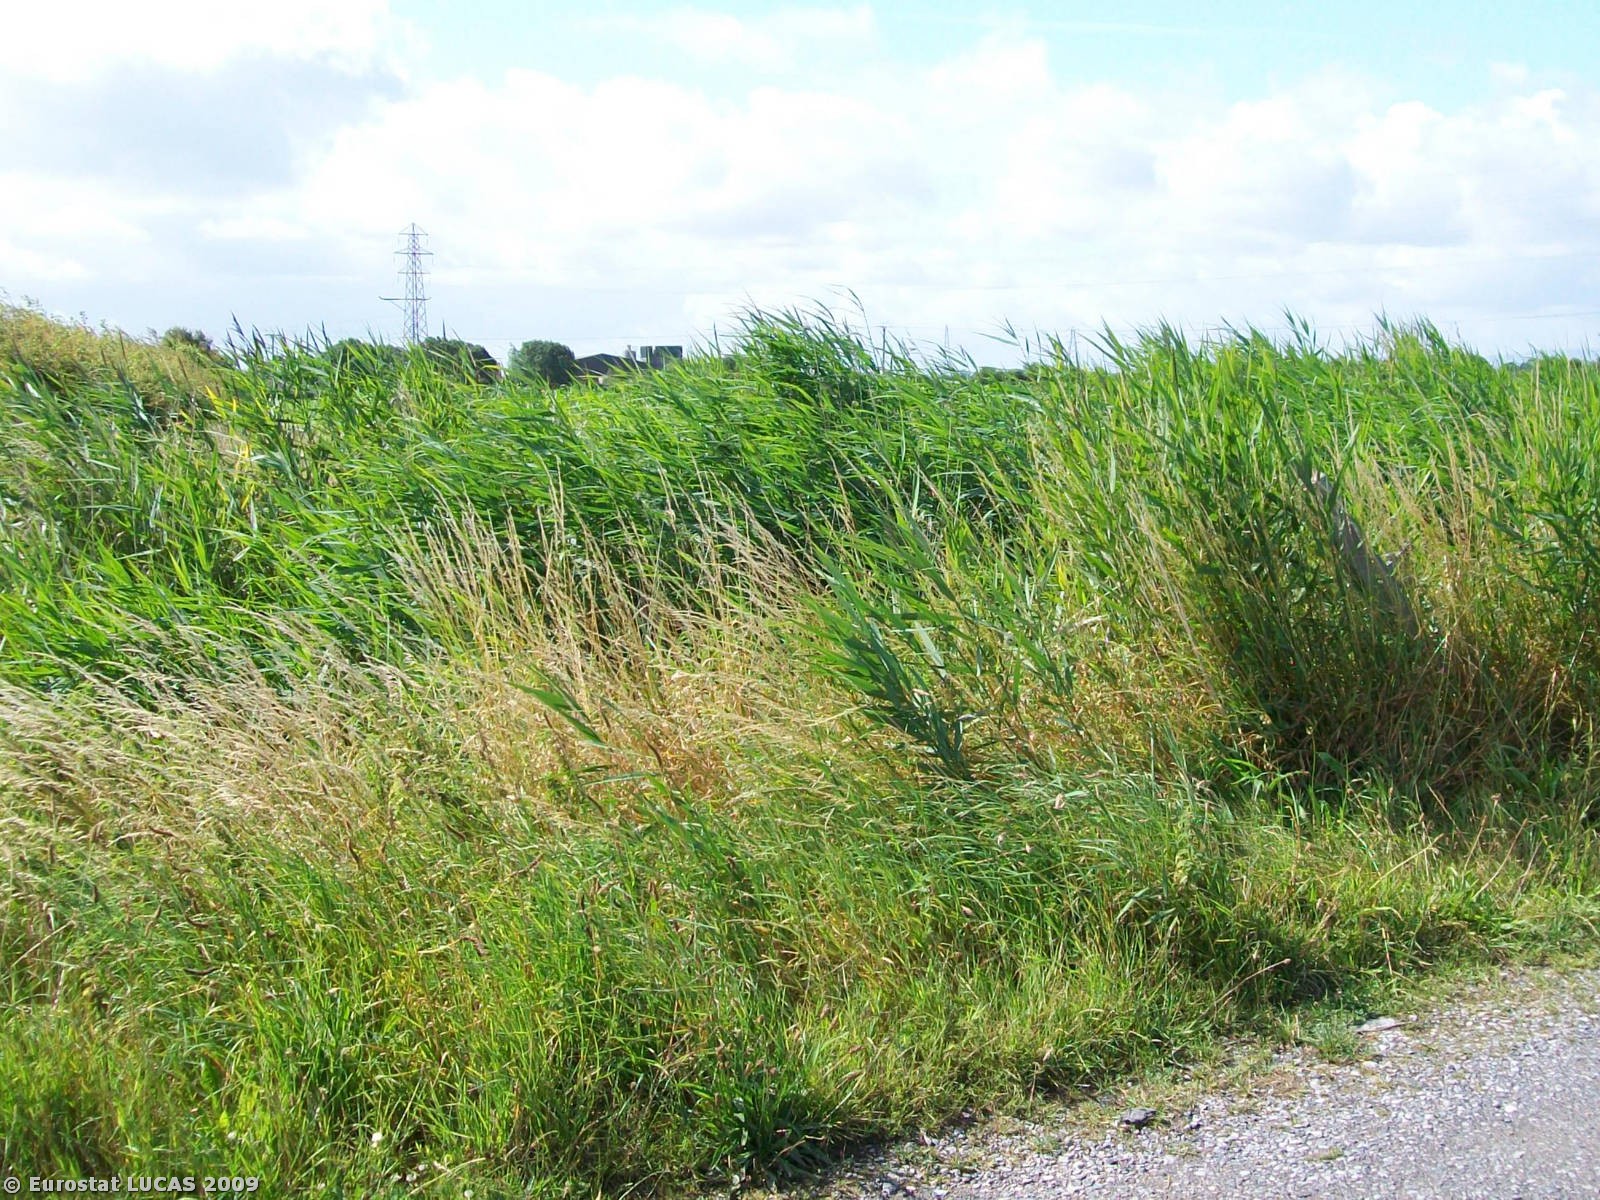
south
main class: Cropland
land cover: Maize
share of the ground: > 75 %
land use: Agriculture (excluding fallow land and kitchen gardens)
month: July
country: GB
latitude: 51.2979
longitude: -2.9679
